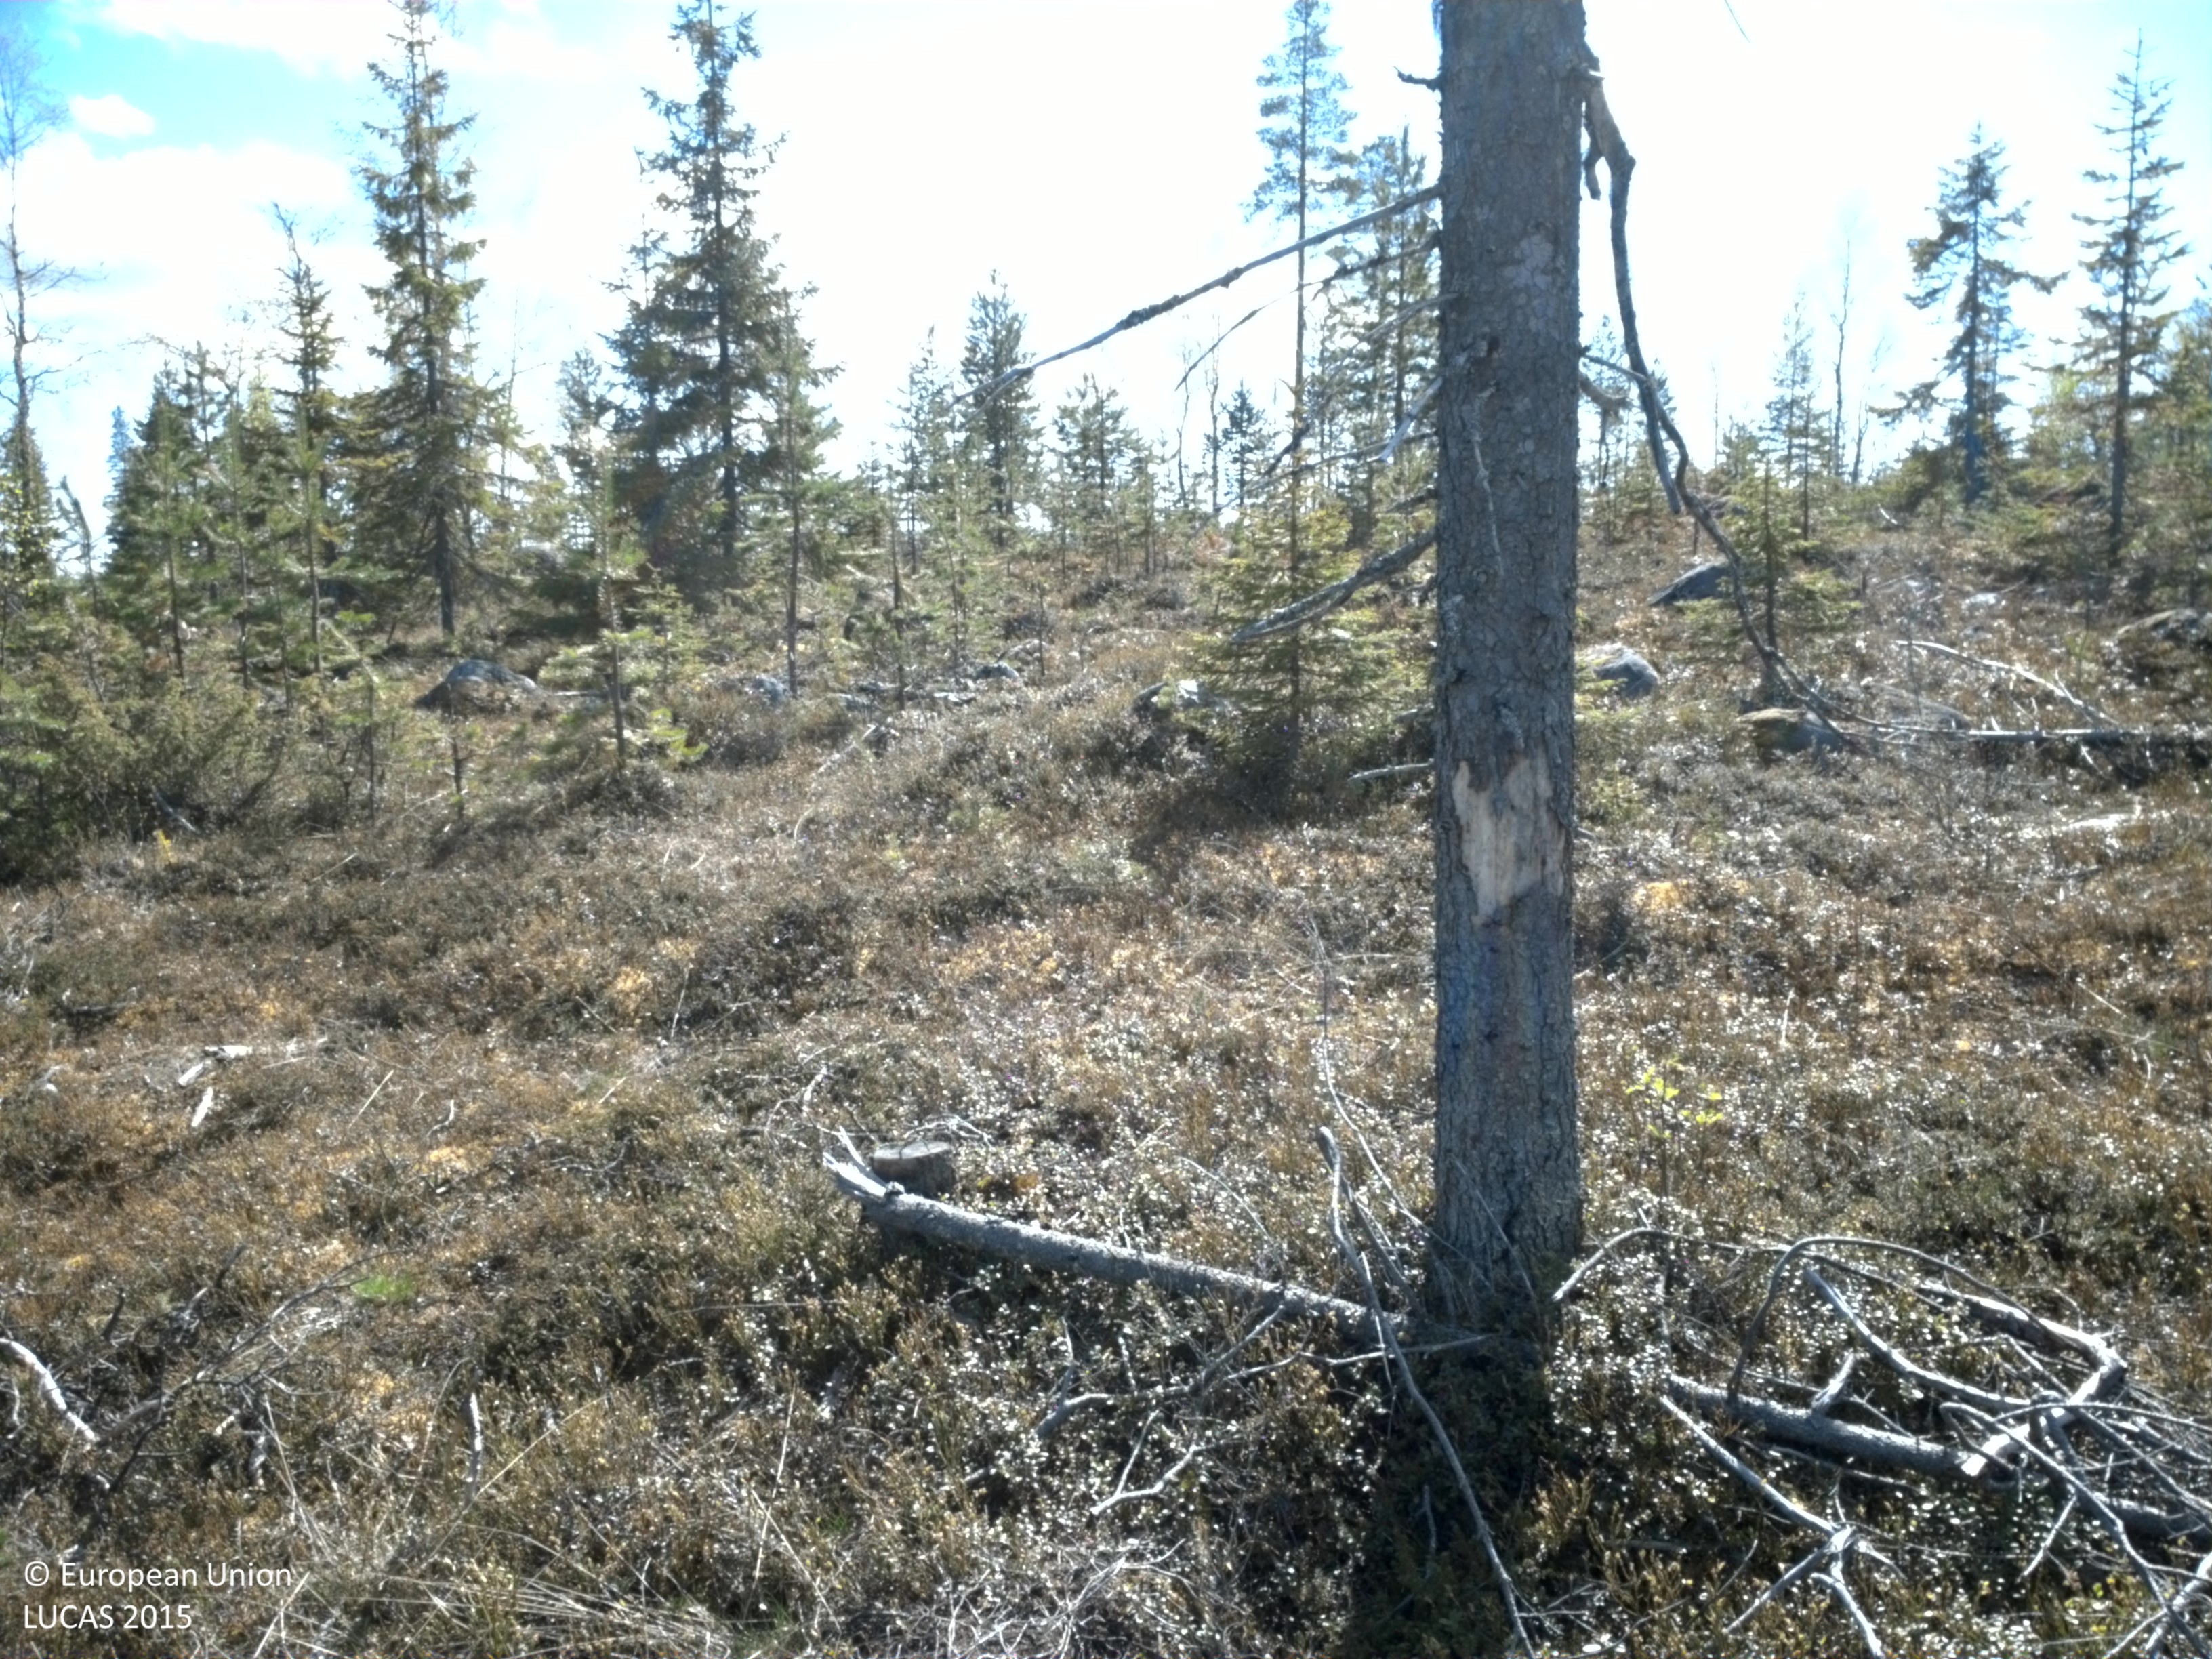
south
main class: Shrubland
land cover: Shrubland with sparse tree cover
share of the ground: > 75 %
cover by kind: shrubs 85 %, unconsolidated bare surface 10 %, coniferous forest trees 5 %
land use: Forestry
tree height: < 5 m
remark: Clear cut
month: May
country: SE
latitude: 66.1267
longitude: 23.1597
